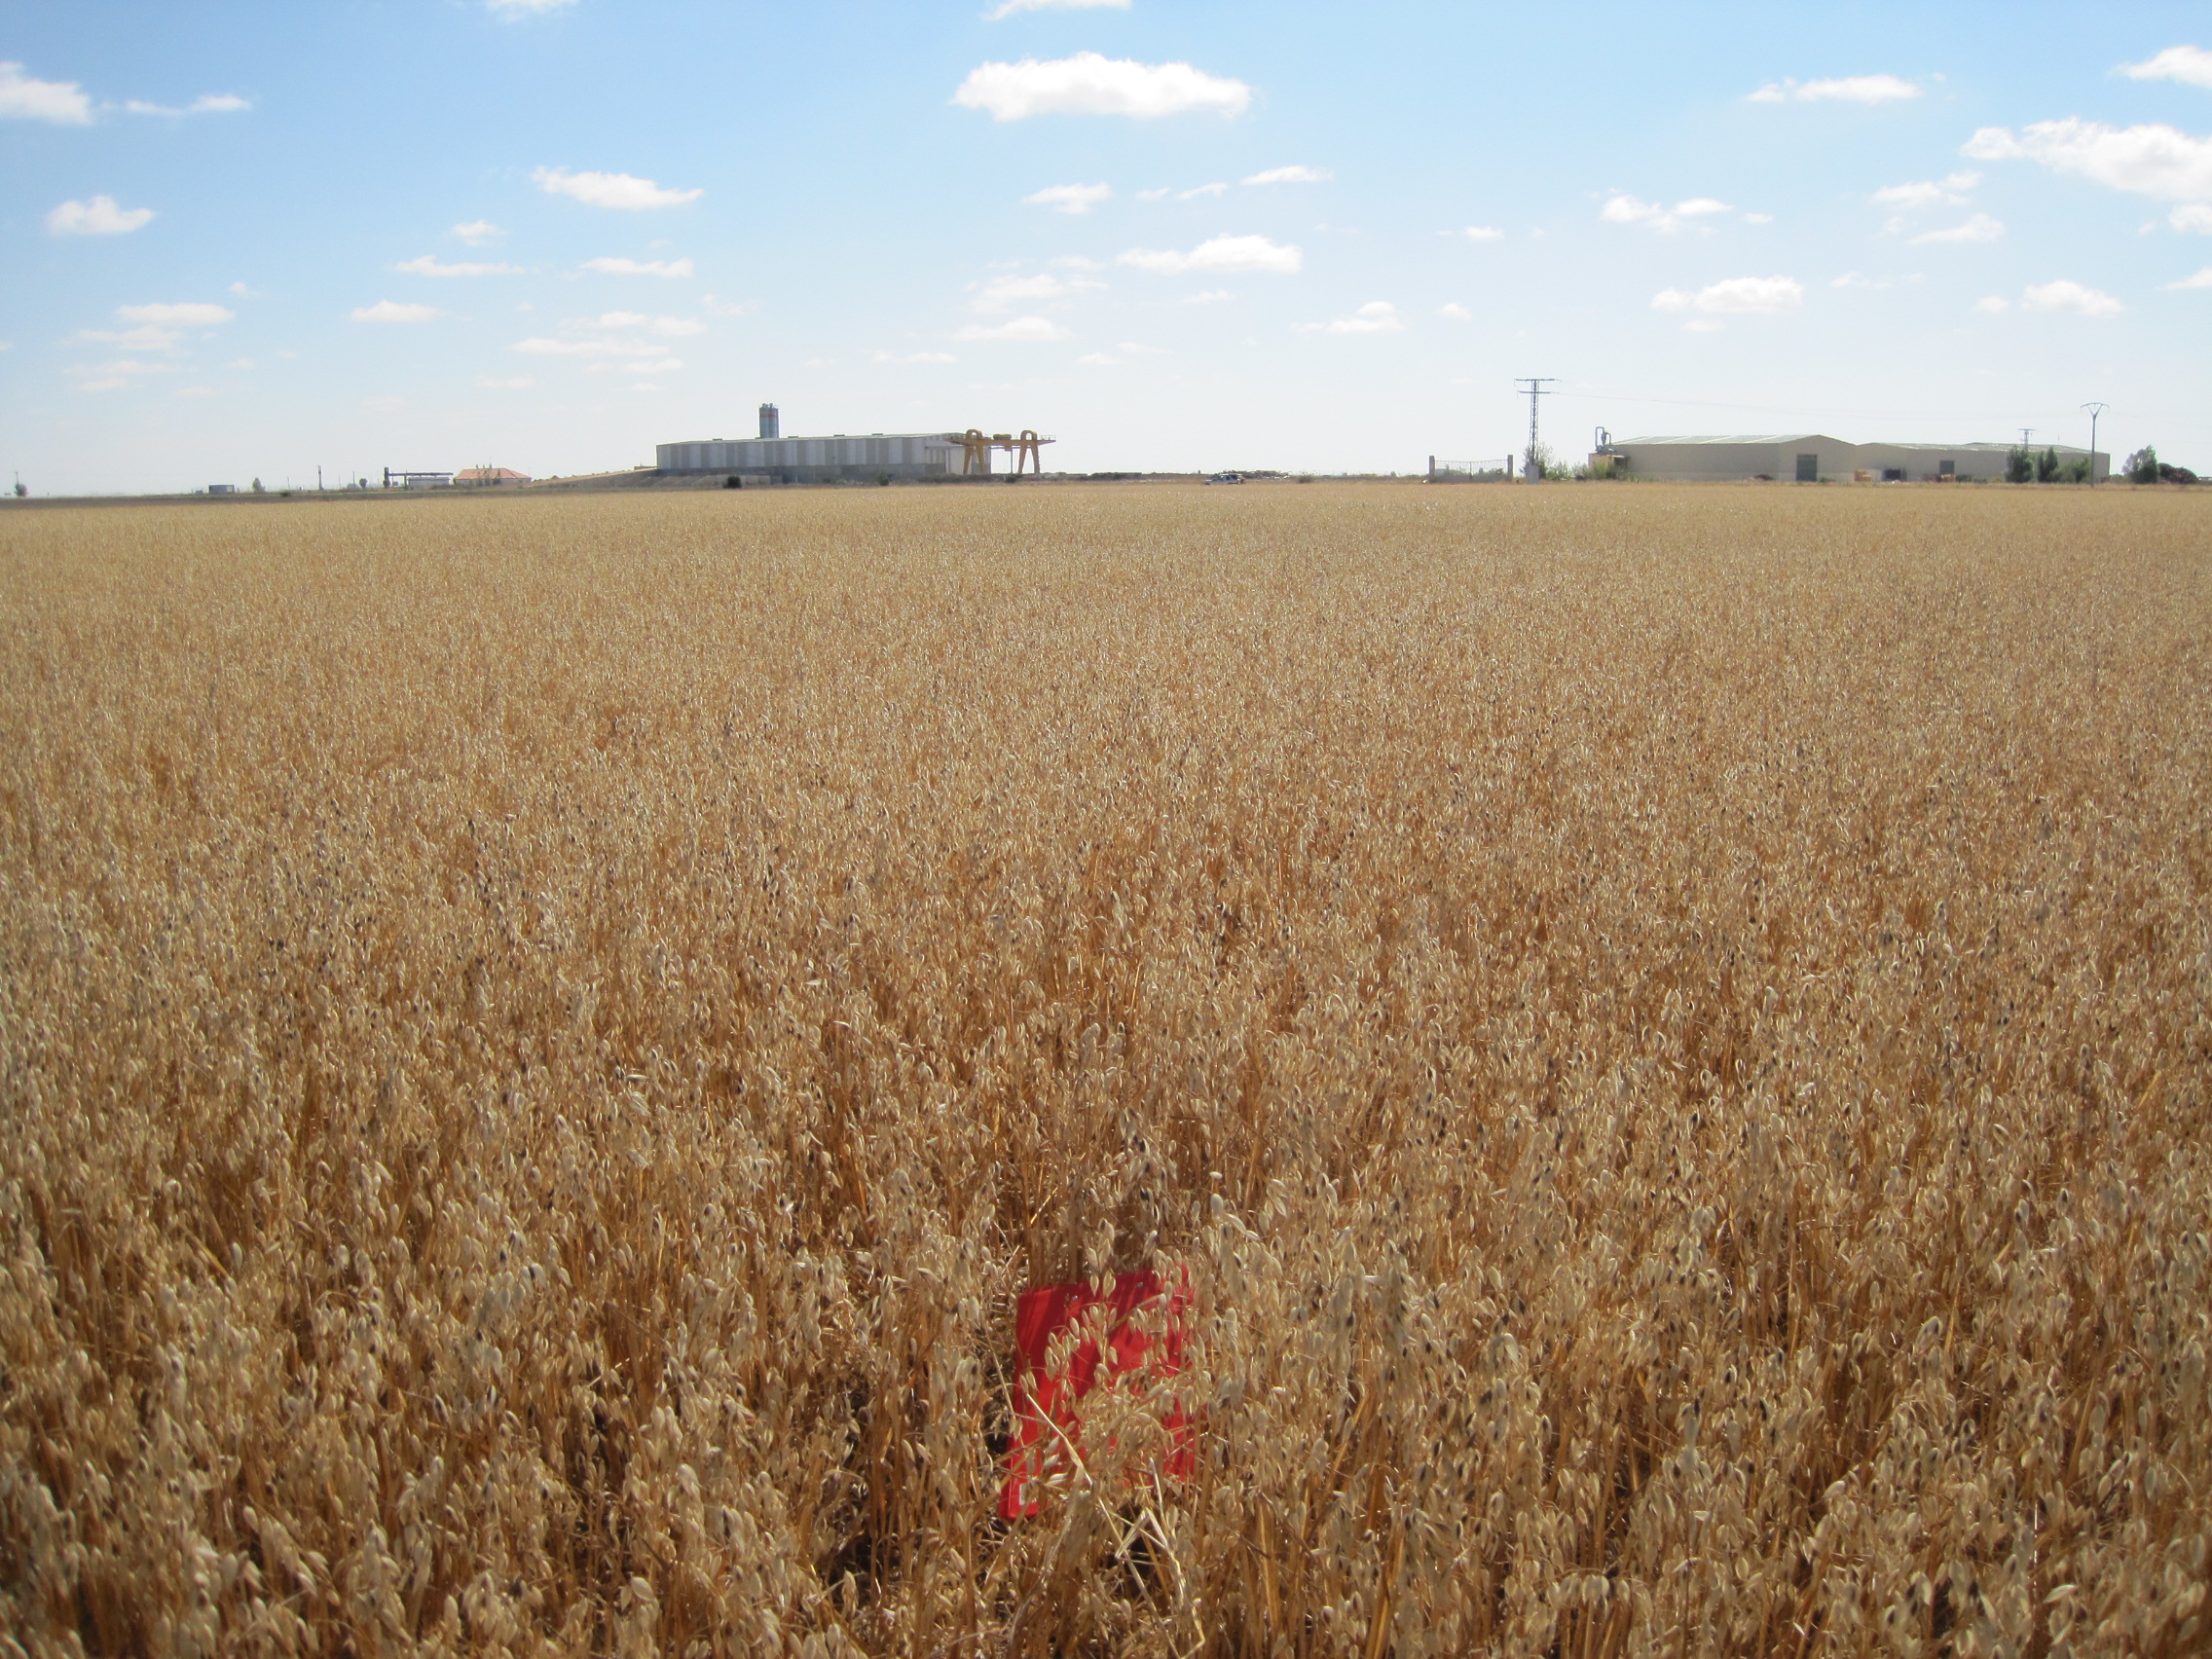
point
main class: Cropland
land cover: Oats
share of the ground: > 75 %
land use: Agriculture (excluding fallow land and kitchen gardens)
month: July
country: ES
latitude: 41.9623
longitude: -5.6432
